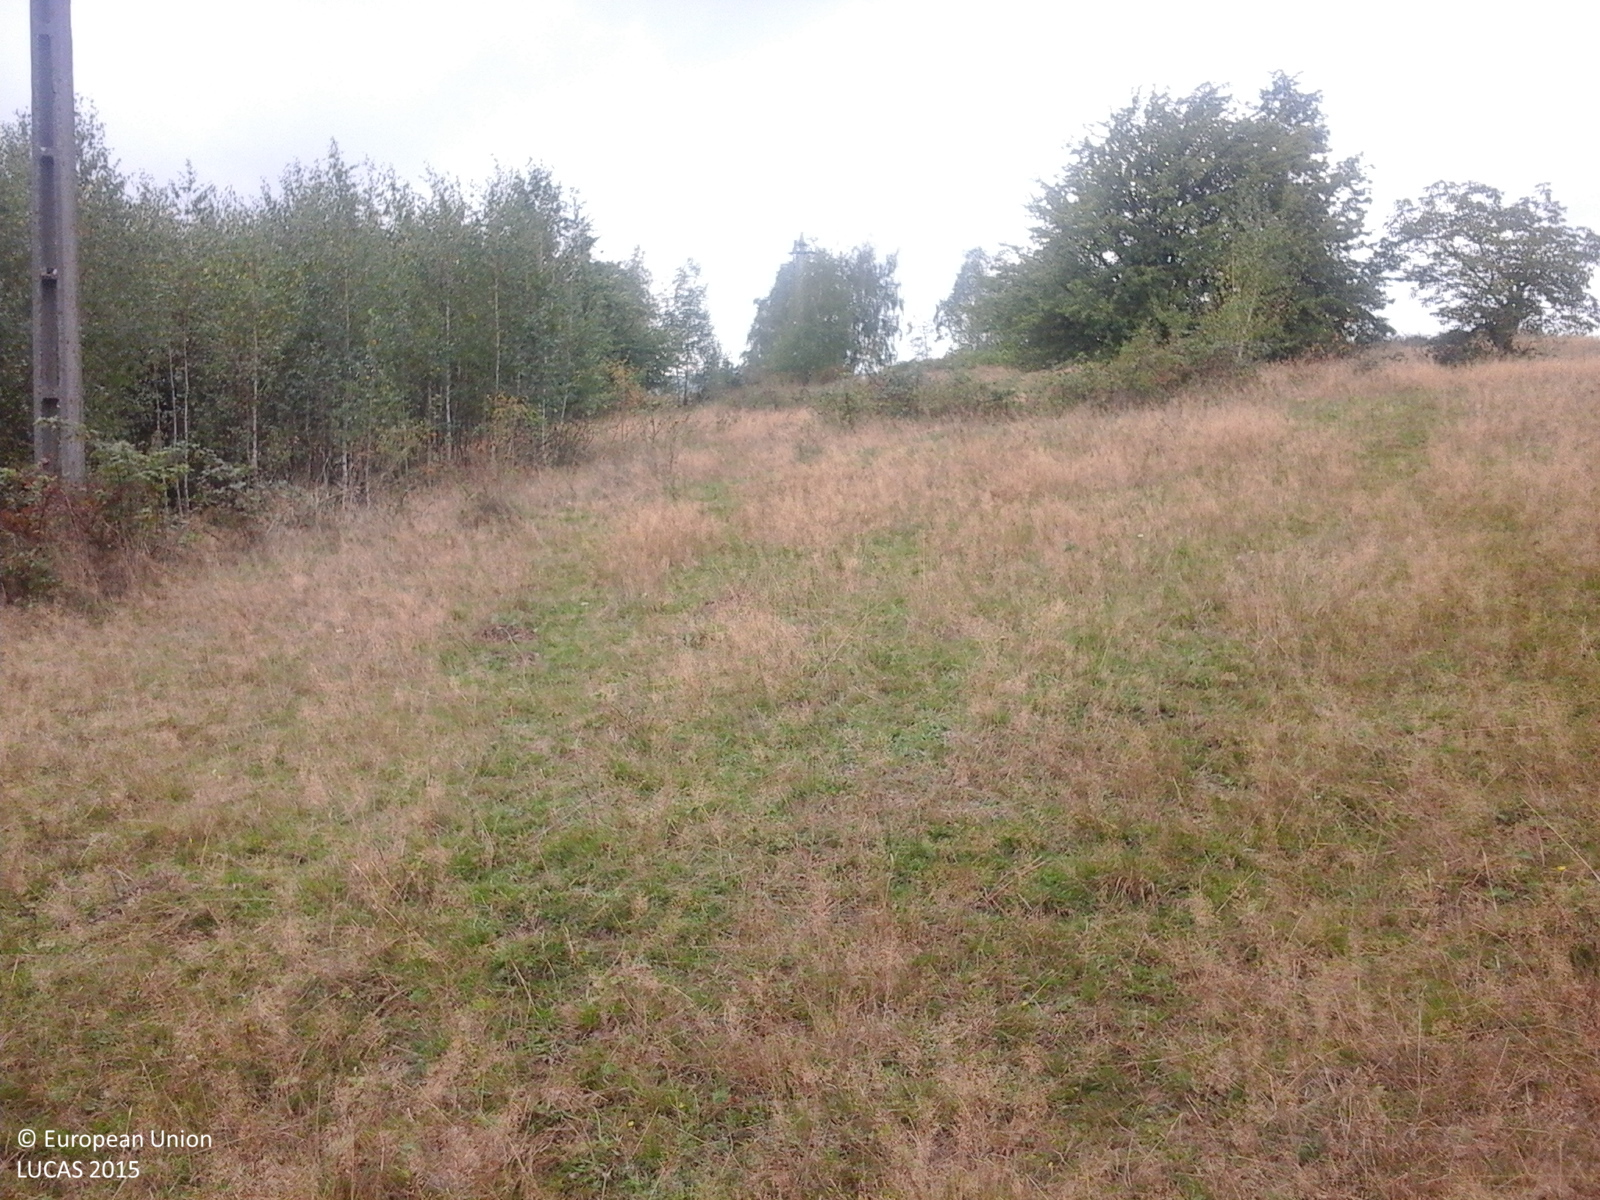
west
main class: Grassland
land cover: Grassland without tree/shrub cover
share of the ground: > 75 %
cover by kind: herbaceous plants 100 %
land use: Agriculture (excluding fallow land and kitchen gardens)
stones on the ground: < 10 %
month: September
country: RO
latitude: 46.9211
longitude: 22.5429
